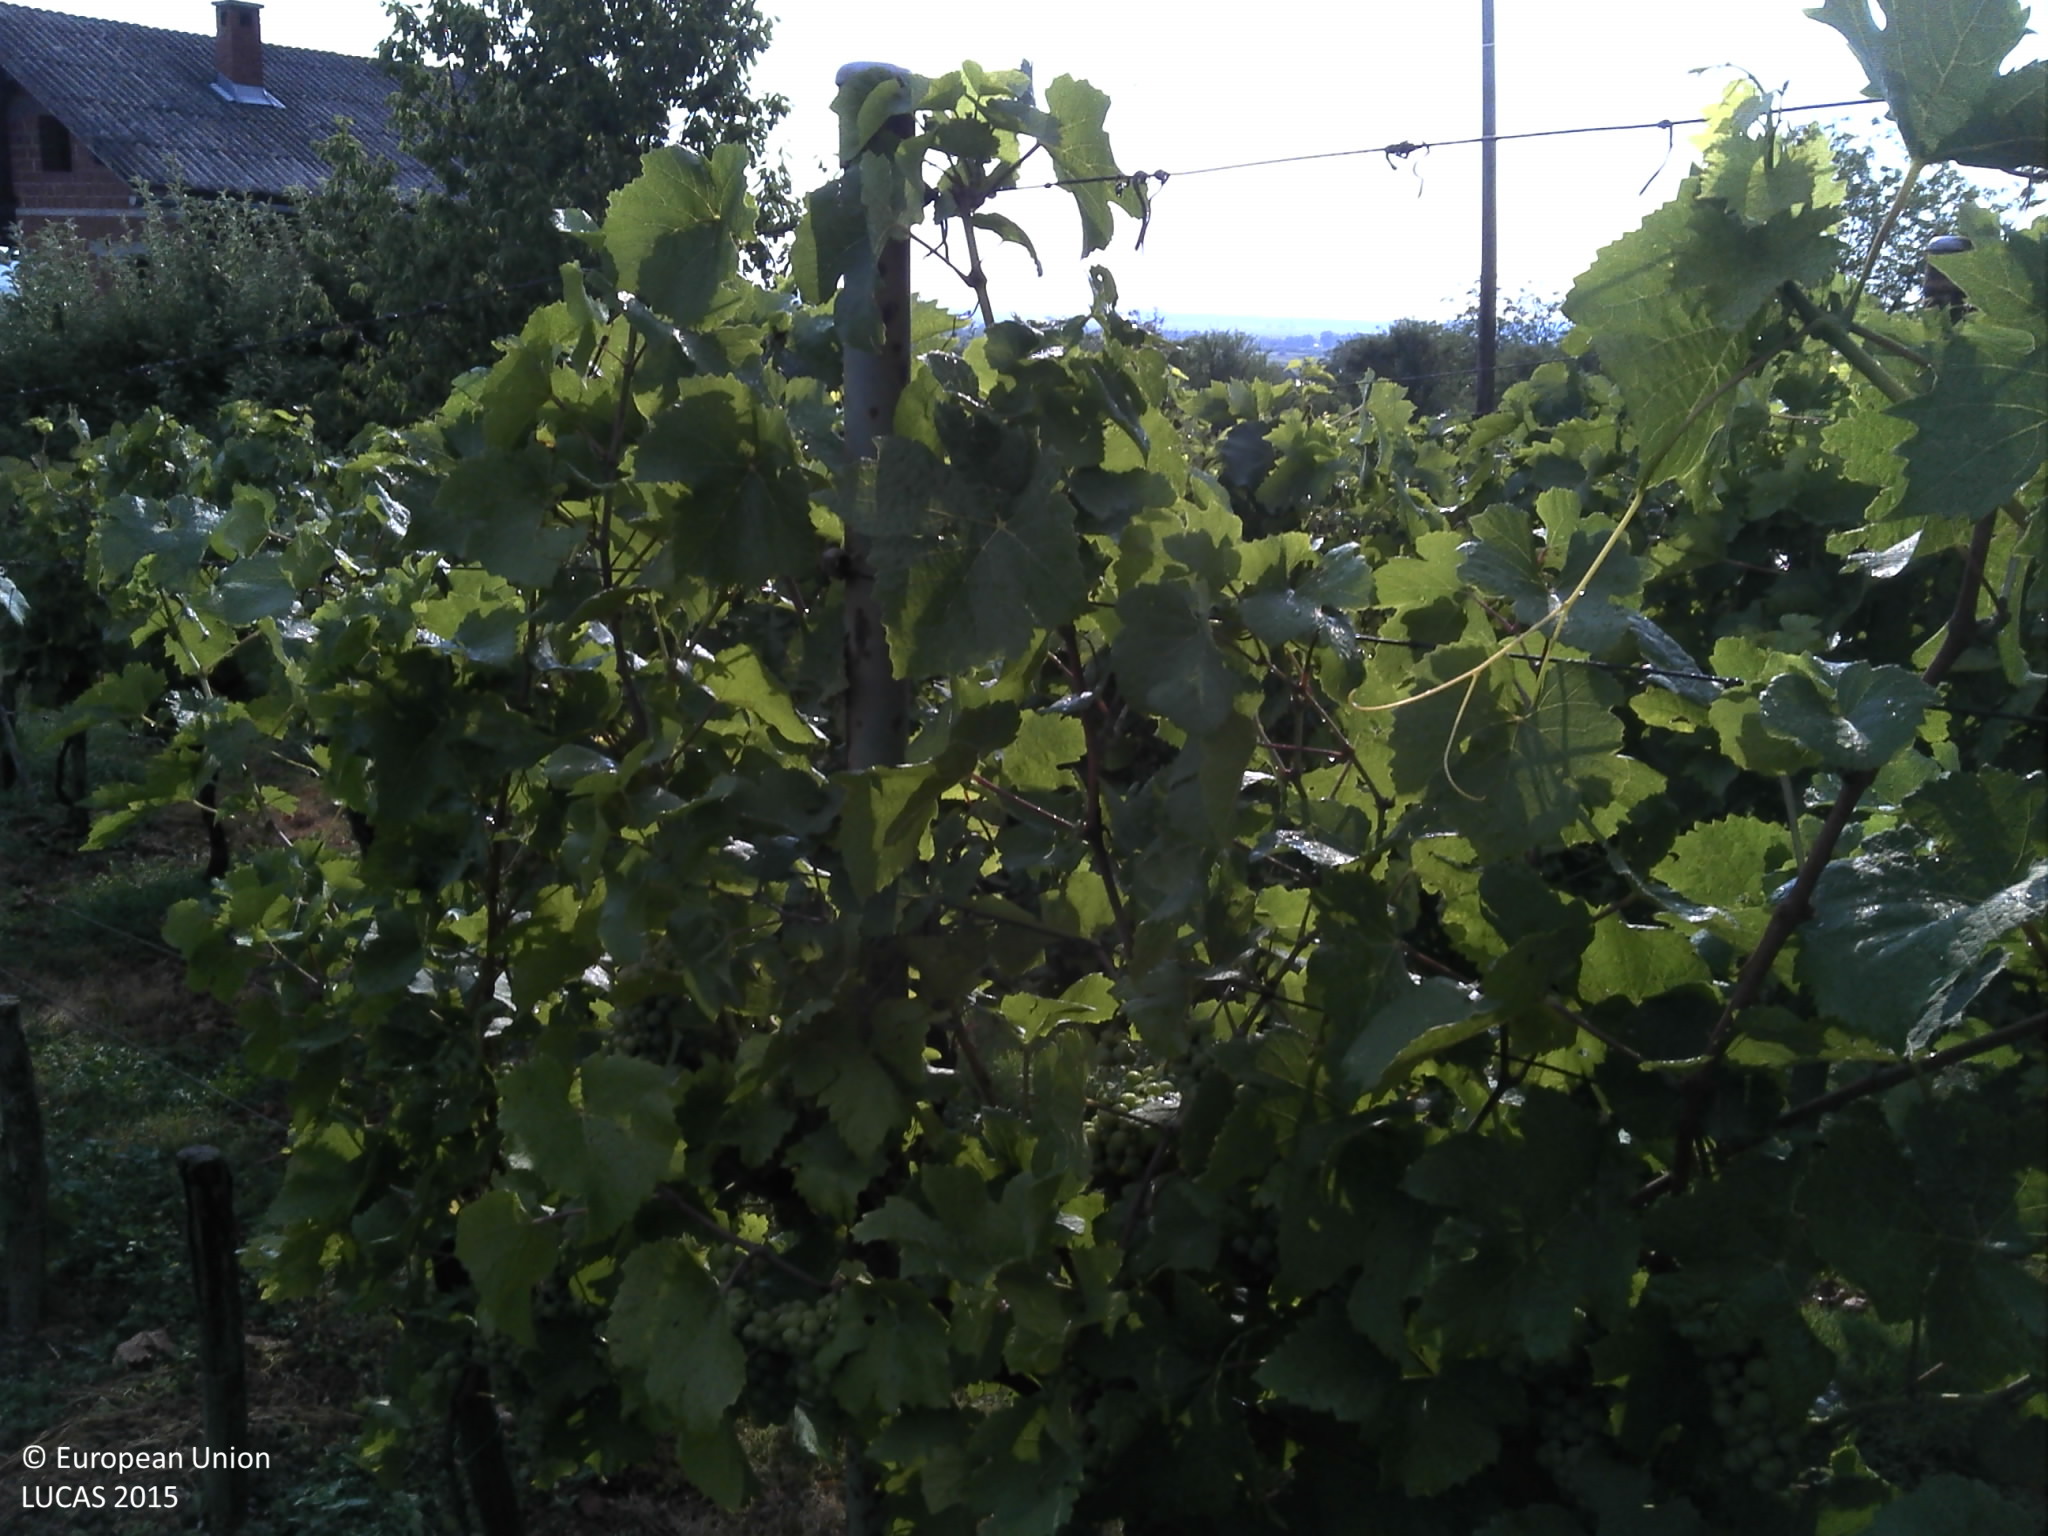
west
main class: Cropland
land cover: Vineyards
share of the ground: 50 - 75 %
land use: Agriculture (excluding fallow land and kitchen gardens)
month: July
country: HR
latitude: 45.5268
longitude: 16.6952
